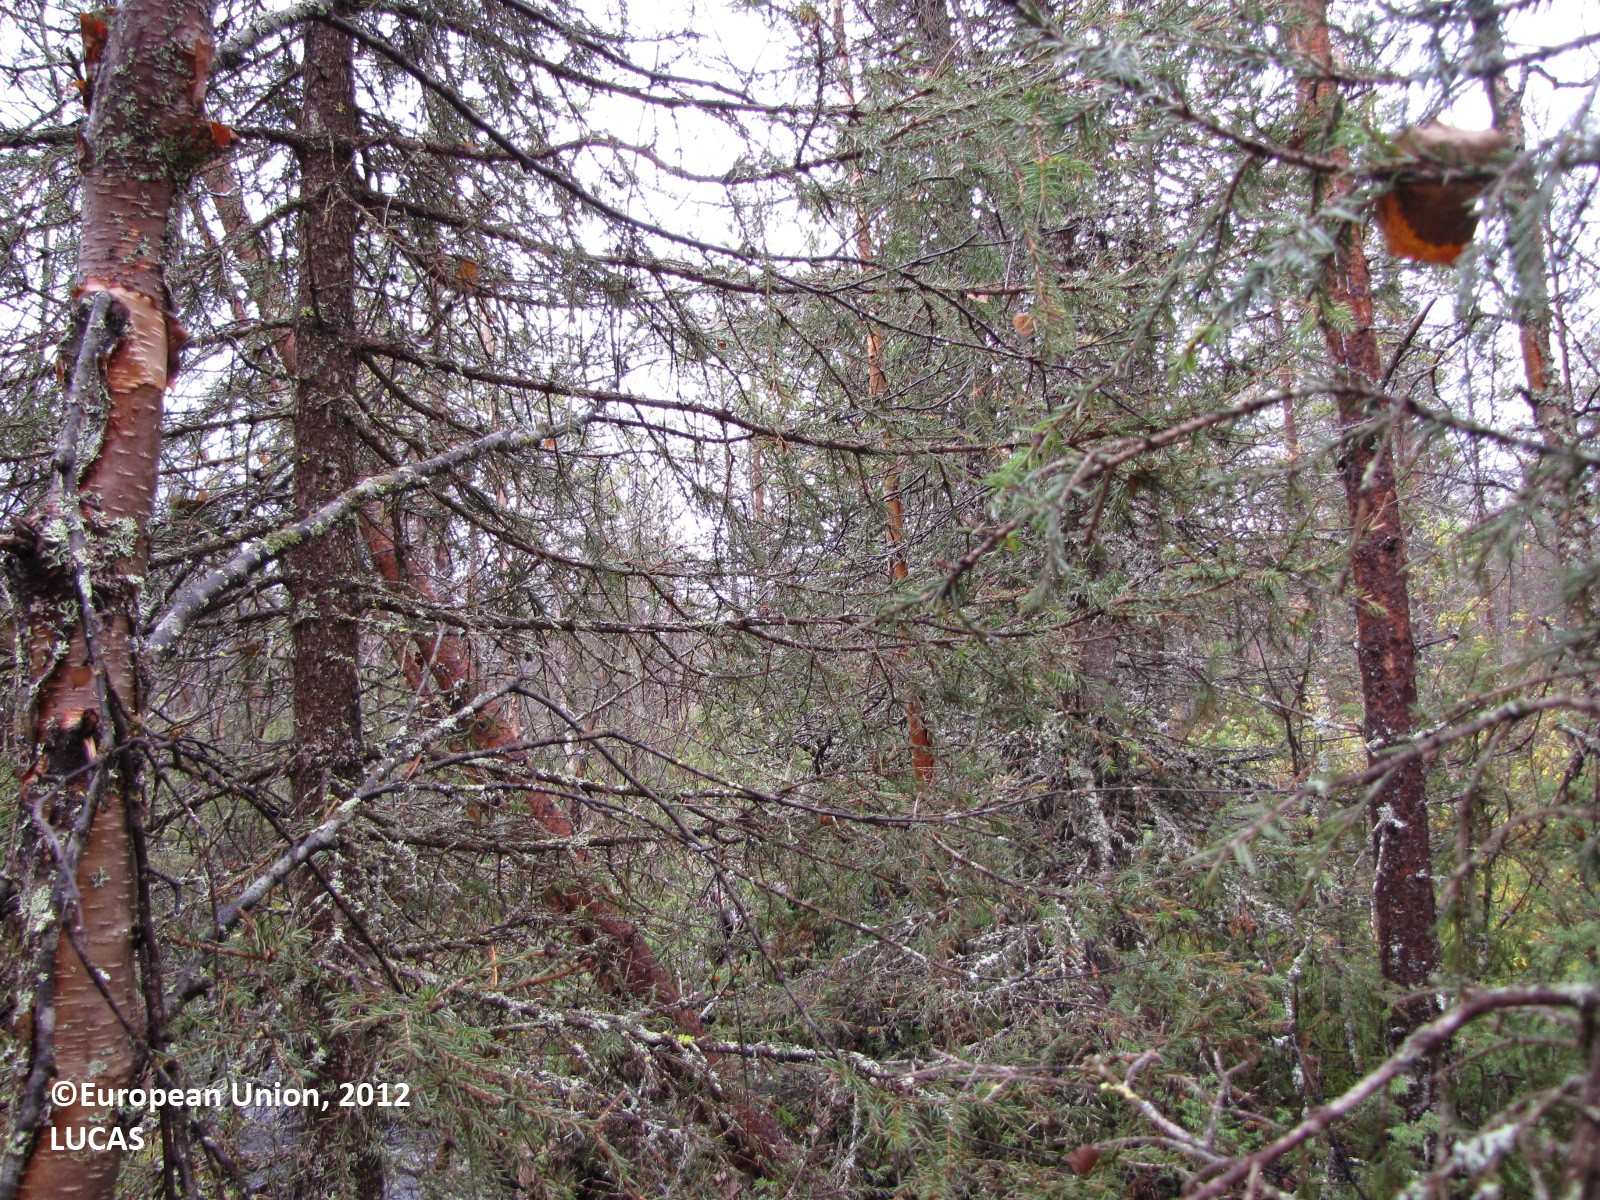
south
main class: Woodland
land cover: Spruce dominated mixed woodland
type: boreal forest
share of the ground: 50 - 75 %
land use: Forestry
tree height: > 5 m
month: September
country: FI
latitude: 67.4975
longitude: 25.3351
